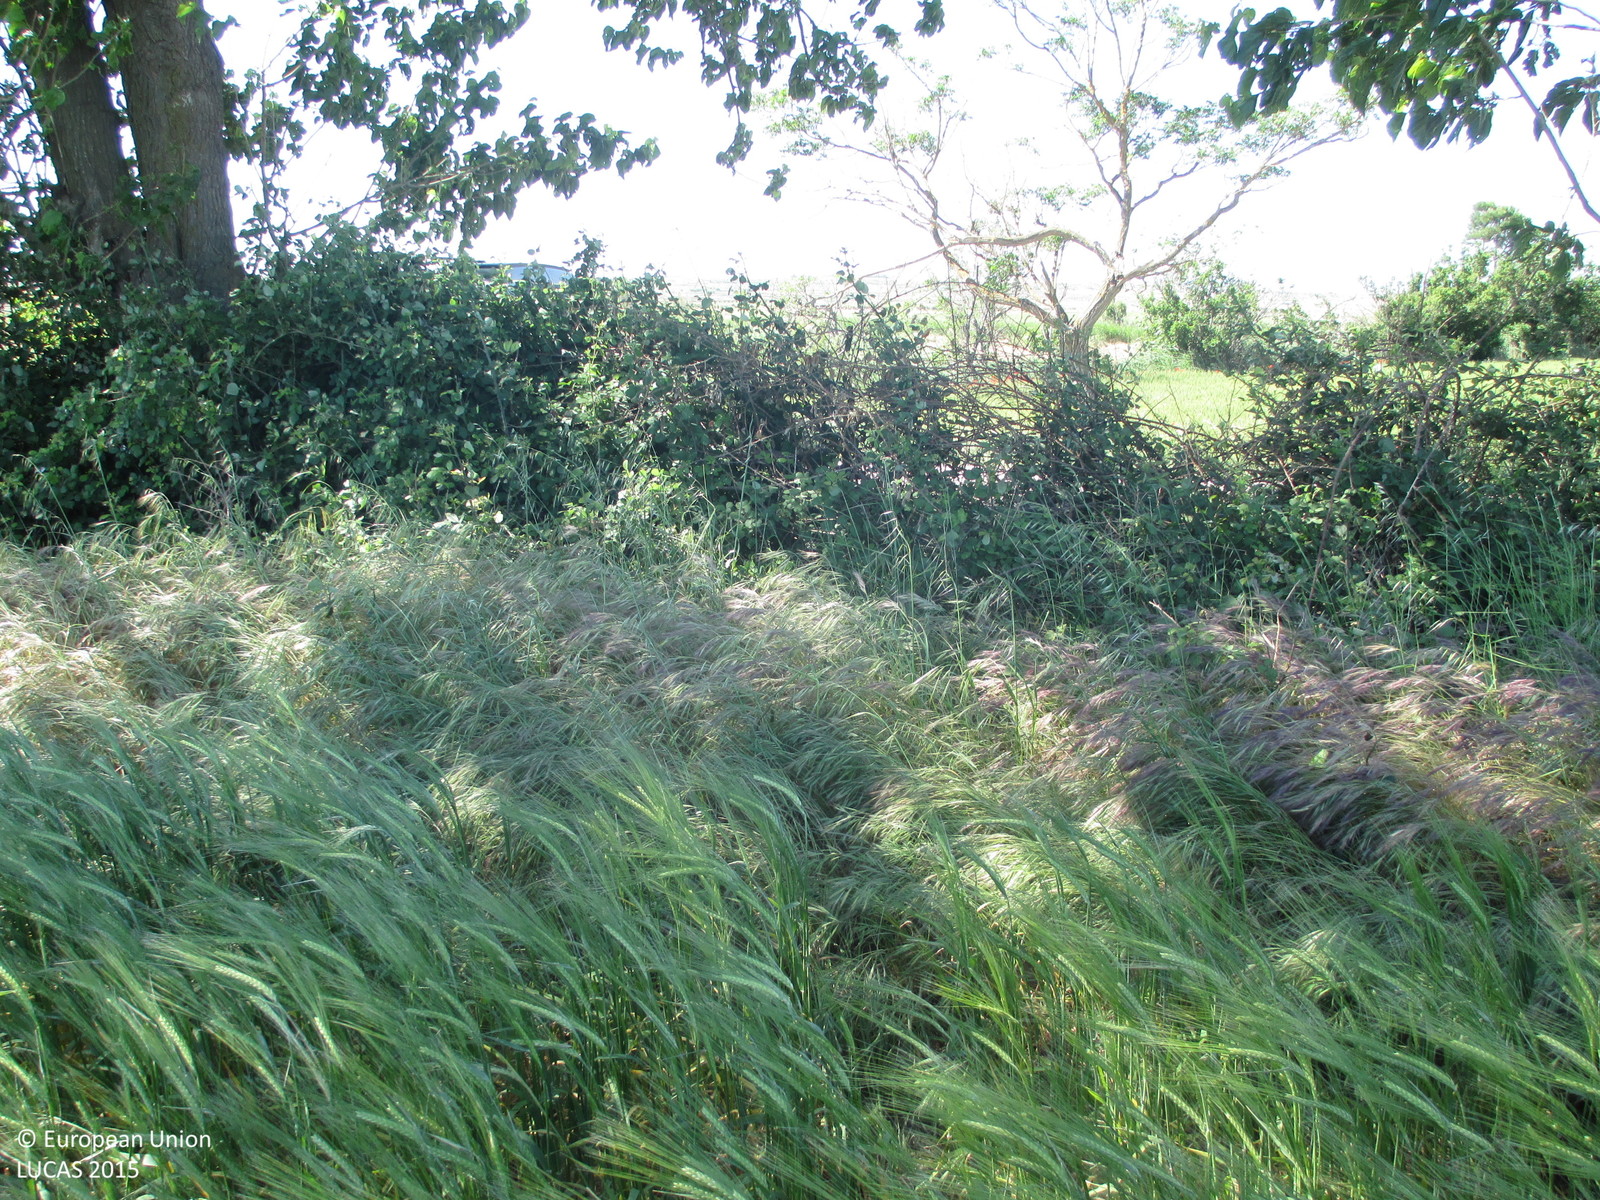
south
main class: Cropland
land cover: Barley
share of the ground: > 75 %
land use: Agriculture (excluding fallow land and kitchen gardens)
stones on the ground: < 10 %
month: May
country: ES
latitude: 41.8675
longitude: -0.1750
